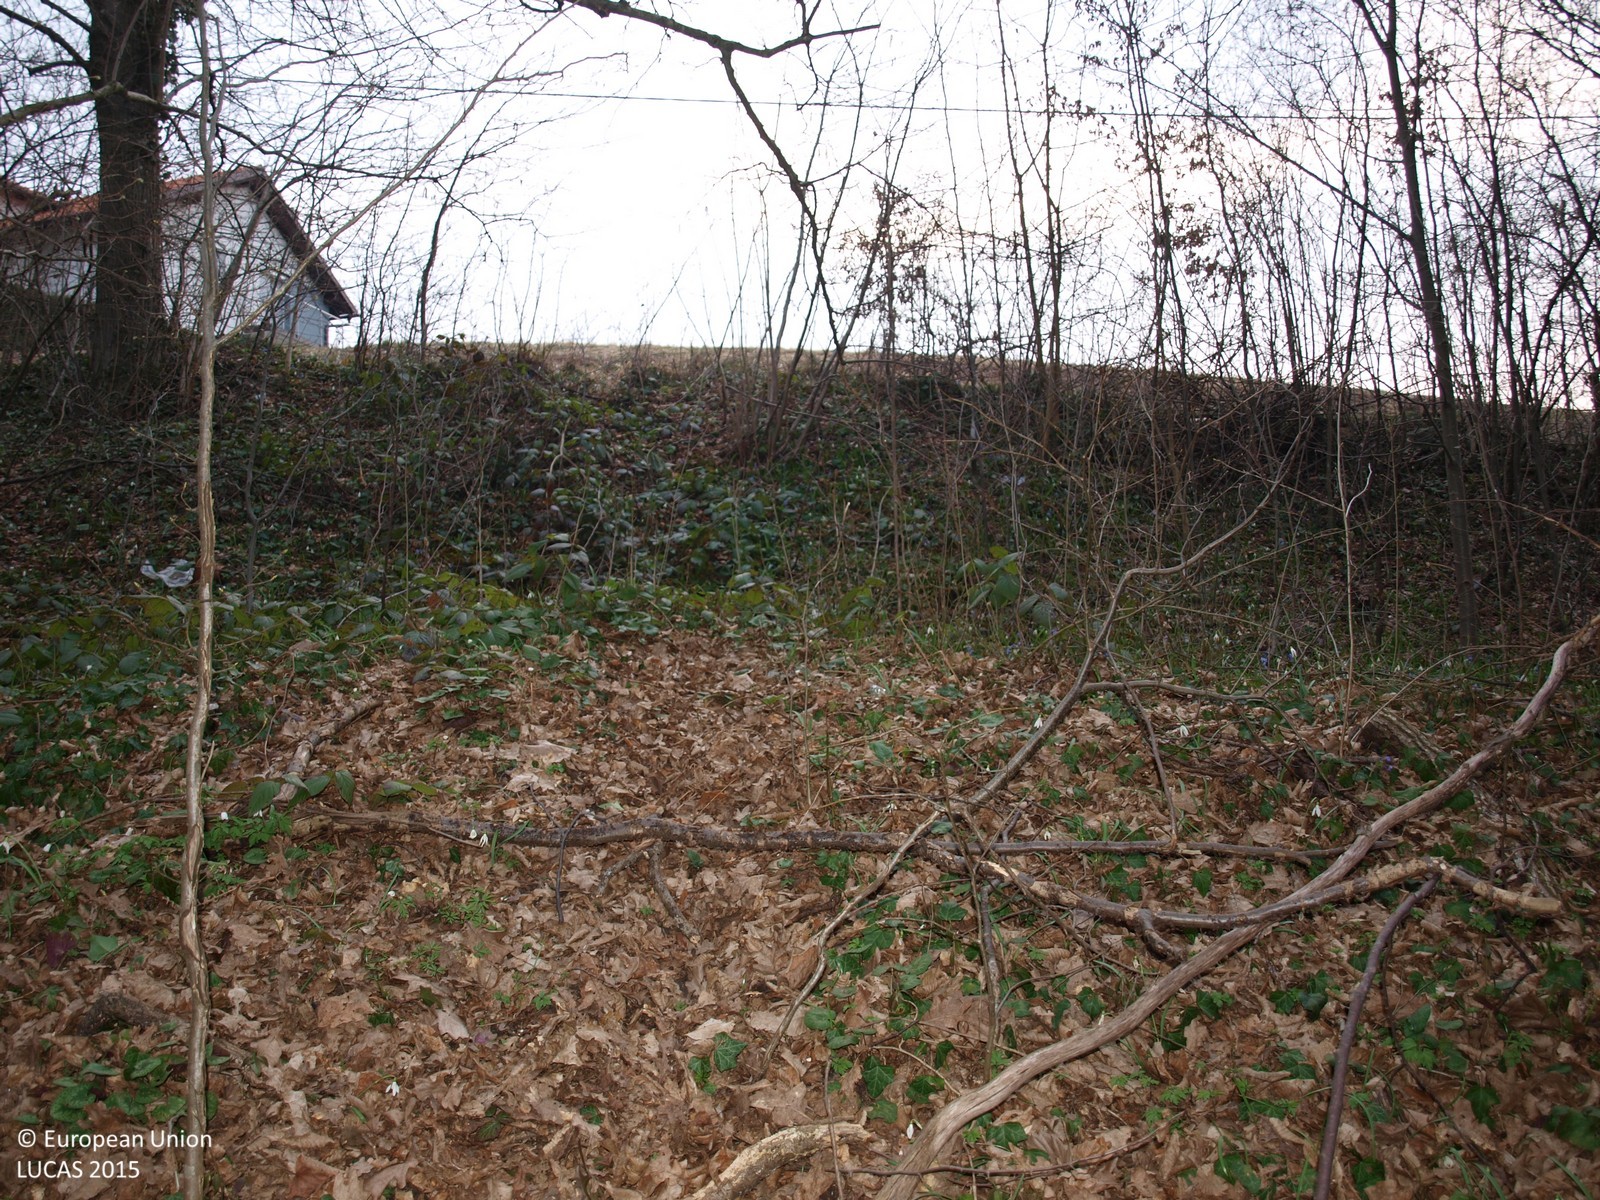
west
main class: Woodland
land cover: Broadleaved woodland
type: mesophytic deciduous forest
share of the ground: > 75 %
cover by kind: broadleaved forest trees 100 %
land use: Forestry
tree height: > 5 m
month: March
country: HR
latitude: 46.2203
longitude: 15.9754
